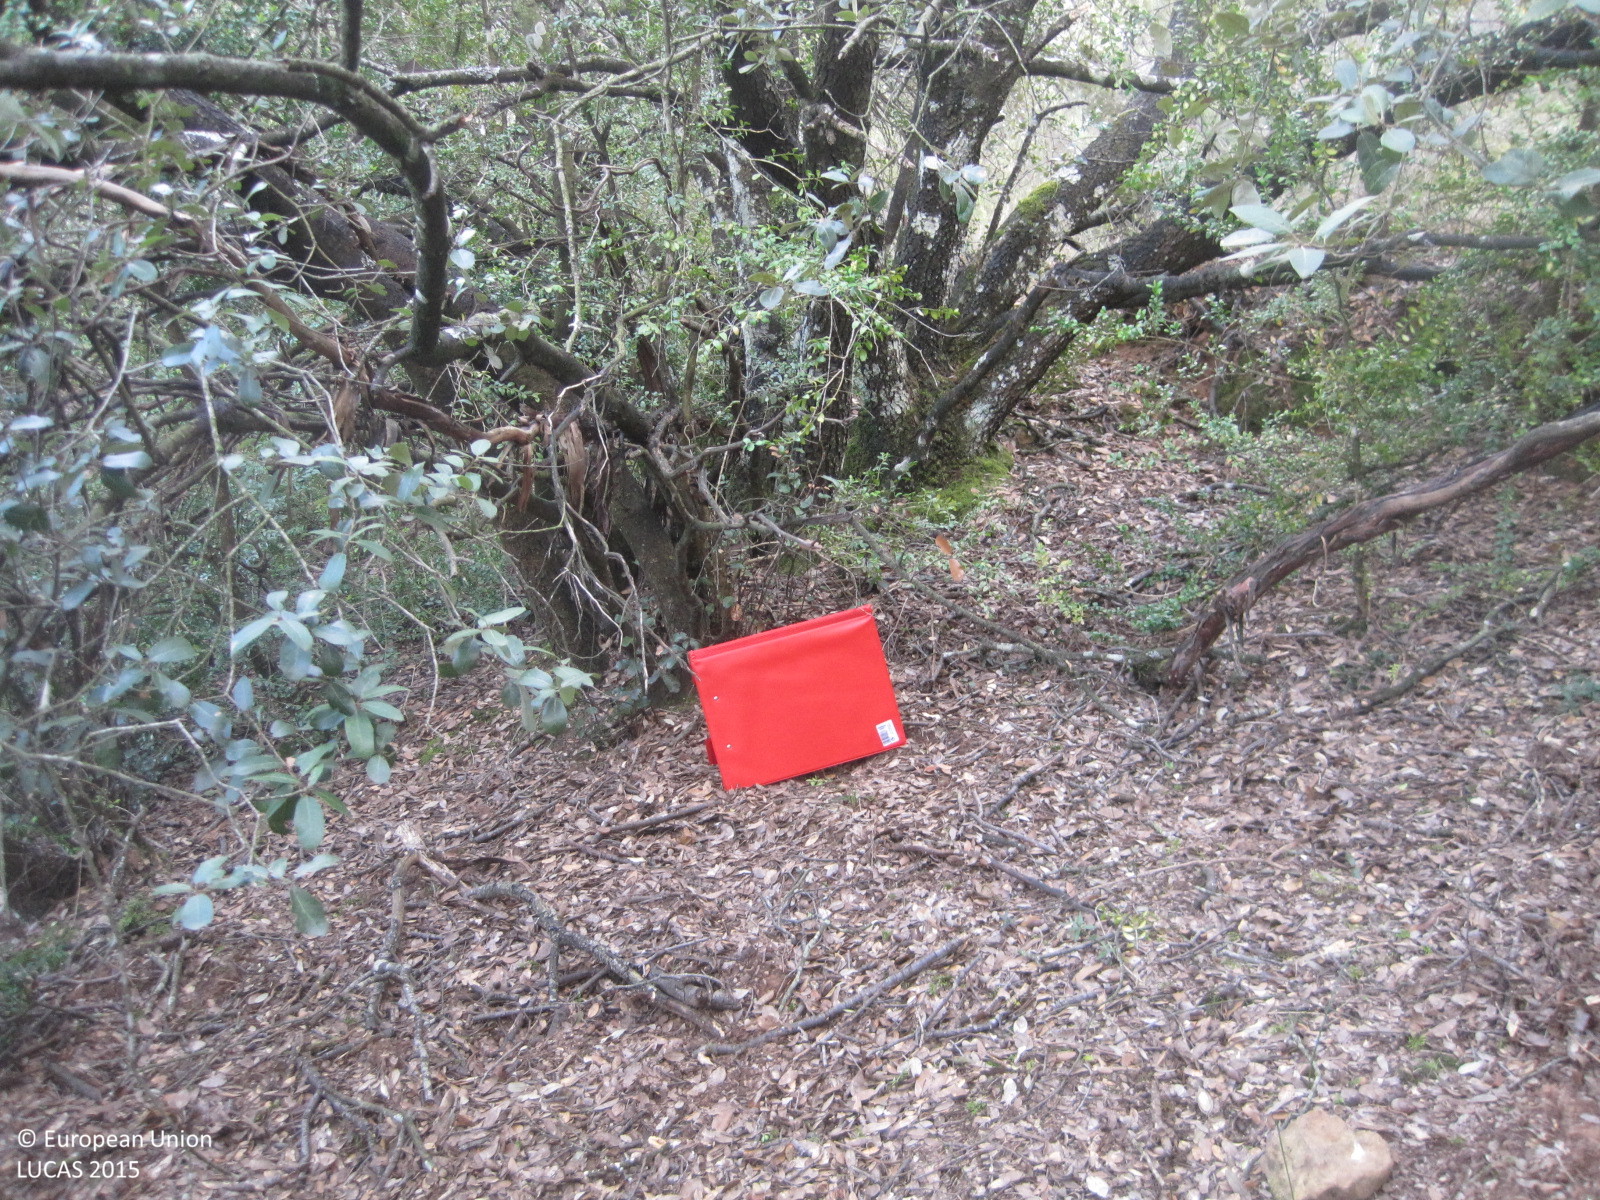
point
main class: Woodland
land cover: Broadleaved woodland
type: acidophilous oak and oak-birch forest
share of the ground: > 75 %
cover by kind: broadleaved forest trees 100 %
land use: Forestry
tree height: > 5 m
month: April
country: ES
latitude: 42.6577
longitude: -2.2311
